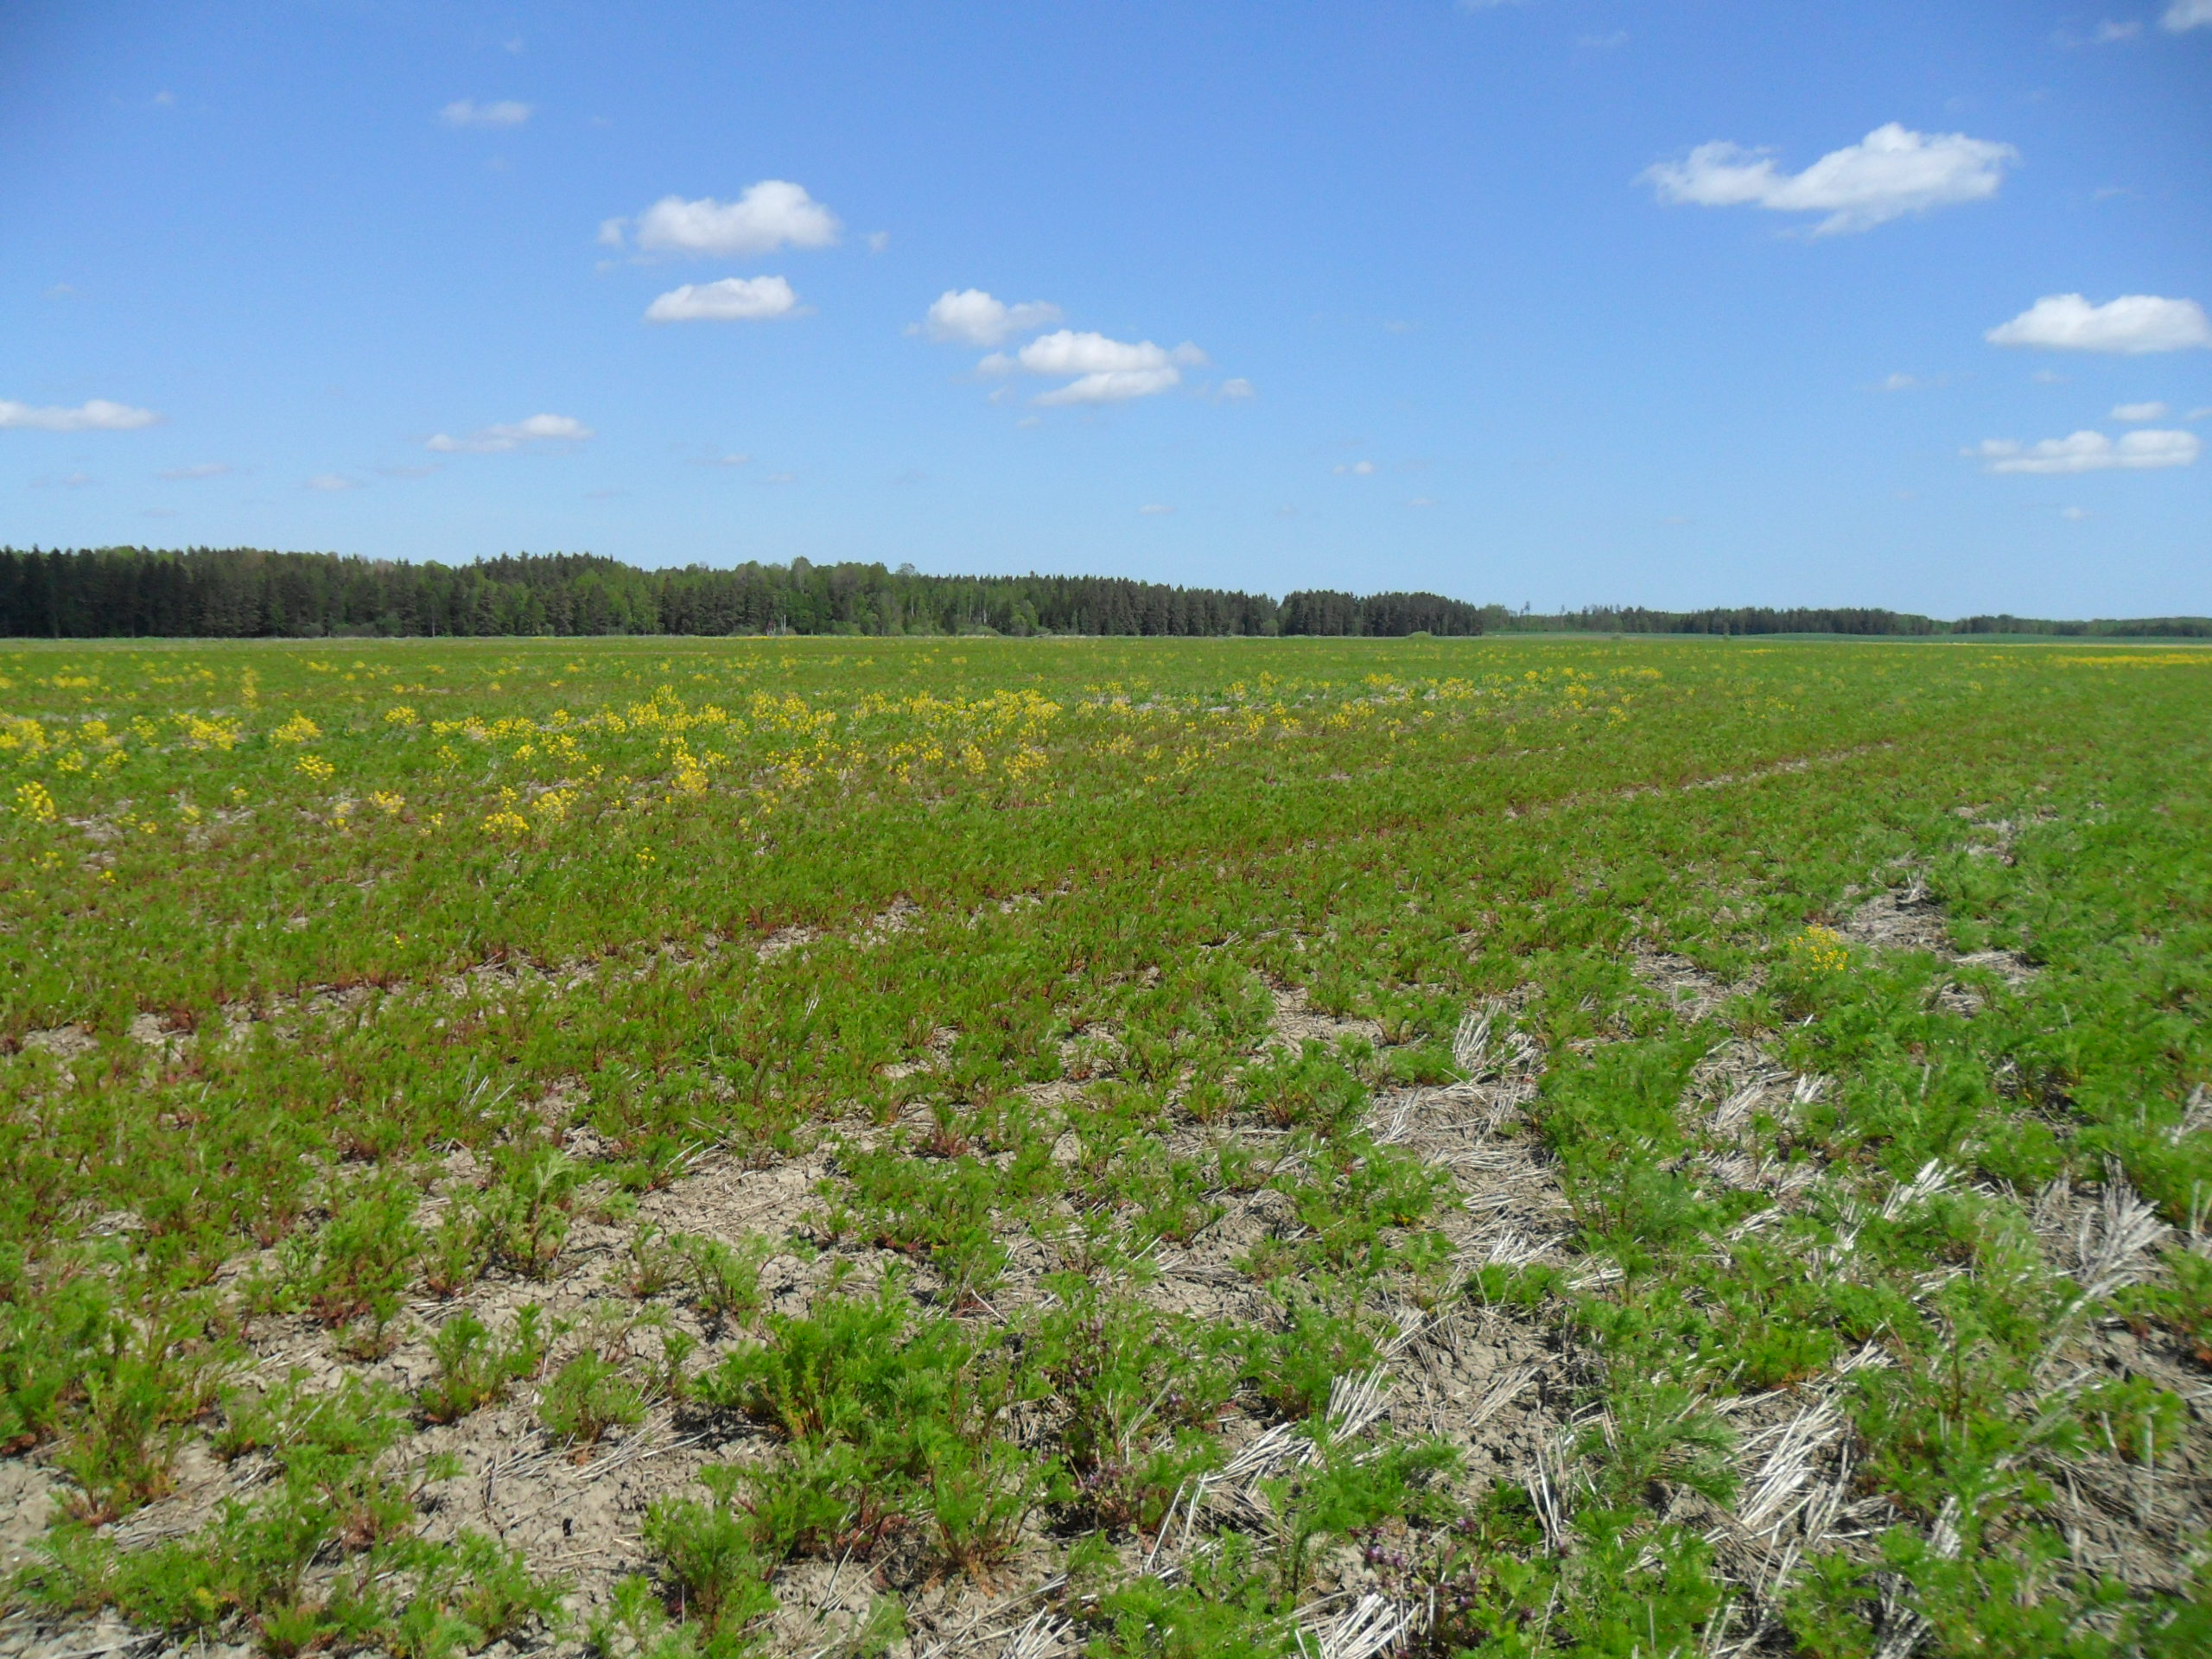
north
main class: Grassland
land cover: Spontaneously vegetated surfaces
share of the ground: 25 - 50 %
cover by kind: unconsolidated bare surface 55 %, herbaceous plants 45 %
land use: Fallow land
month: May
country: LV
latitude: 57.2801
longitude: 22.3764
